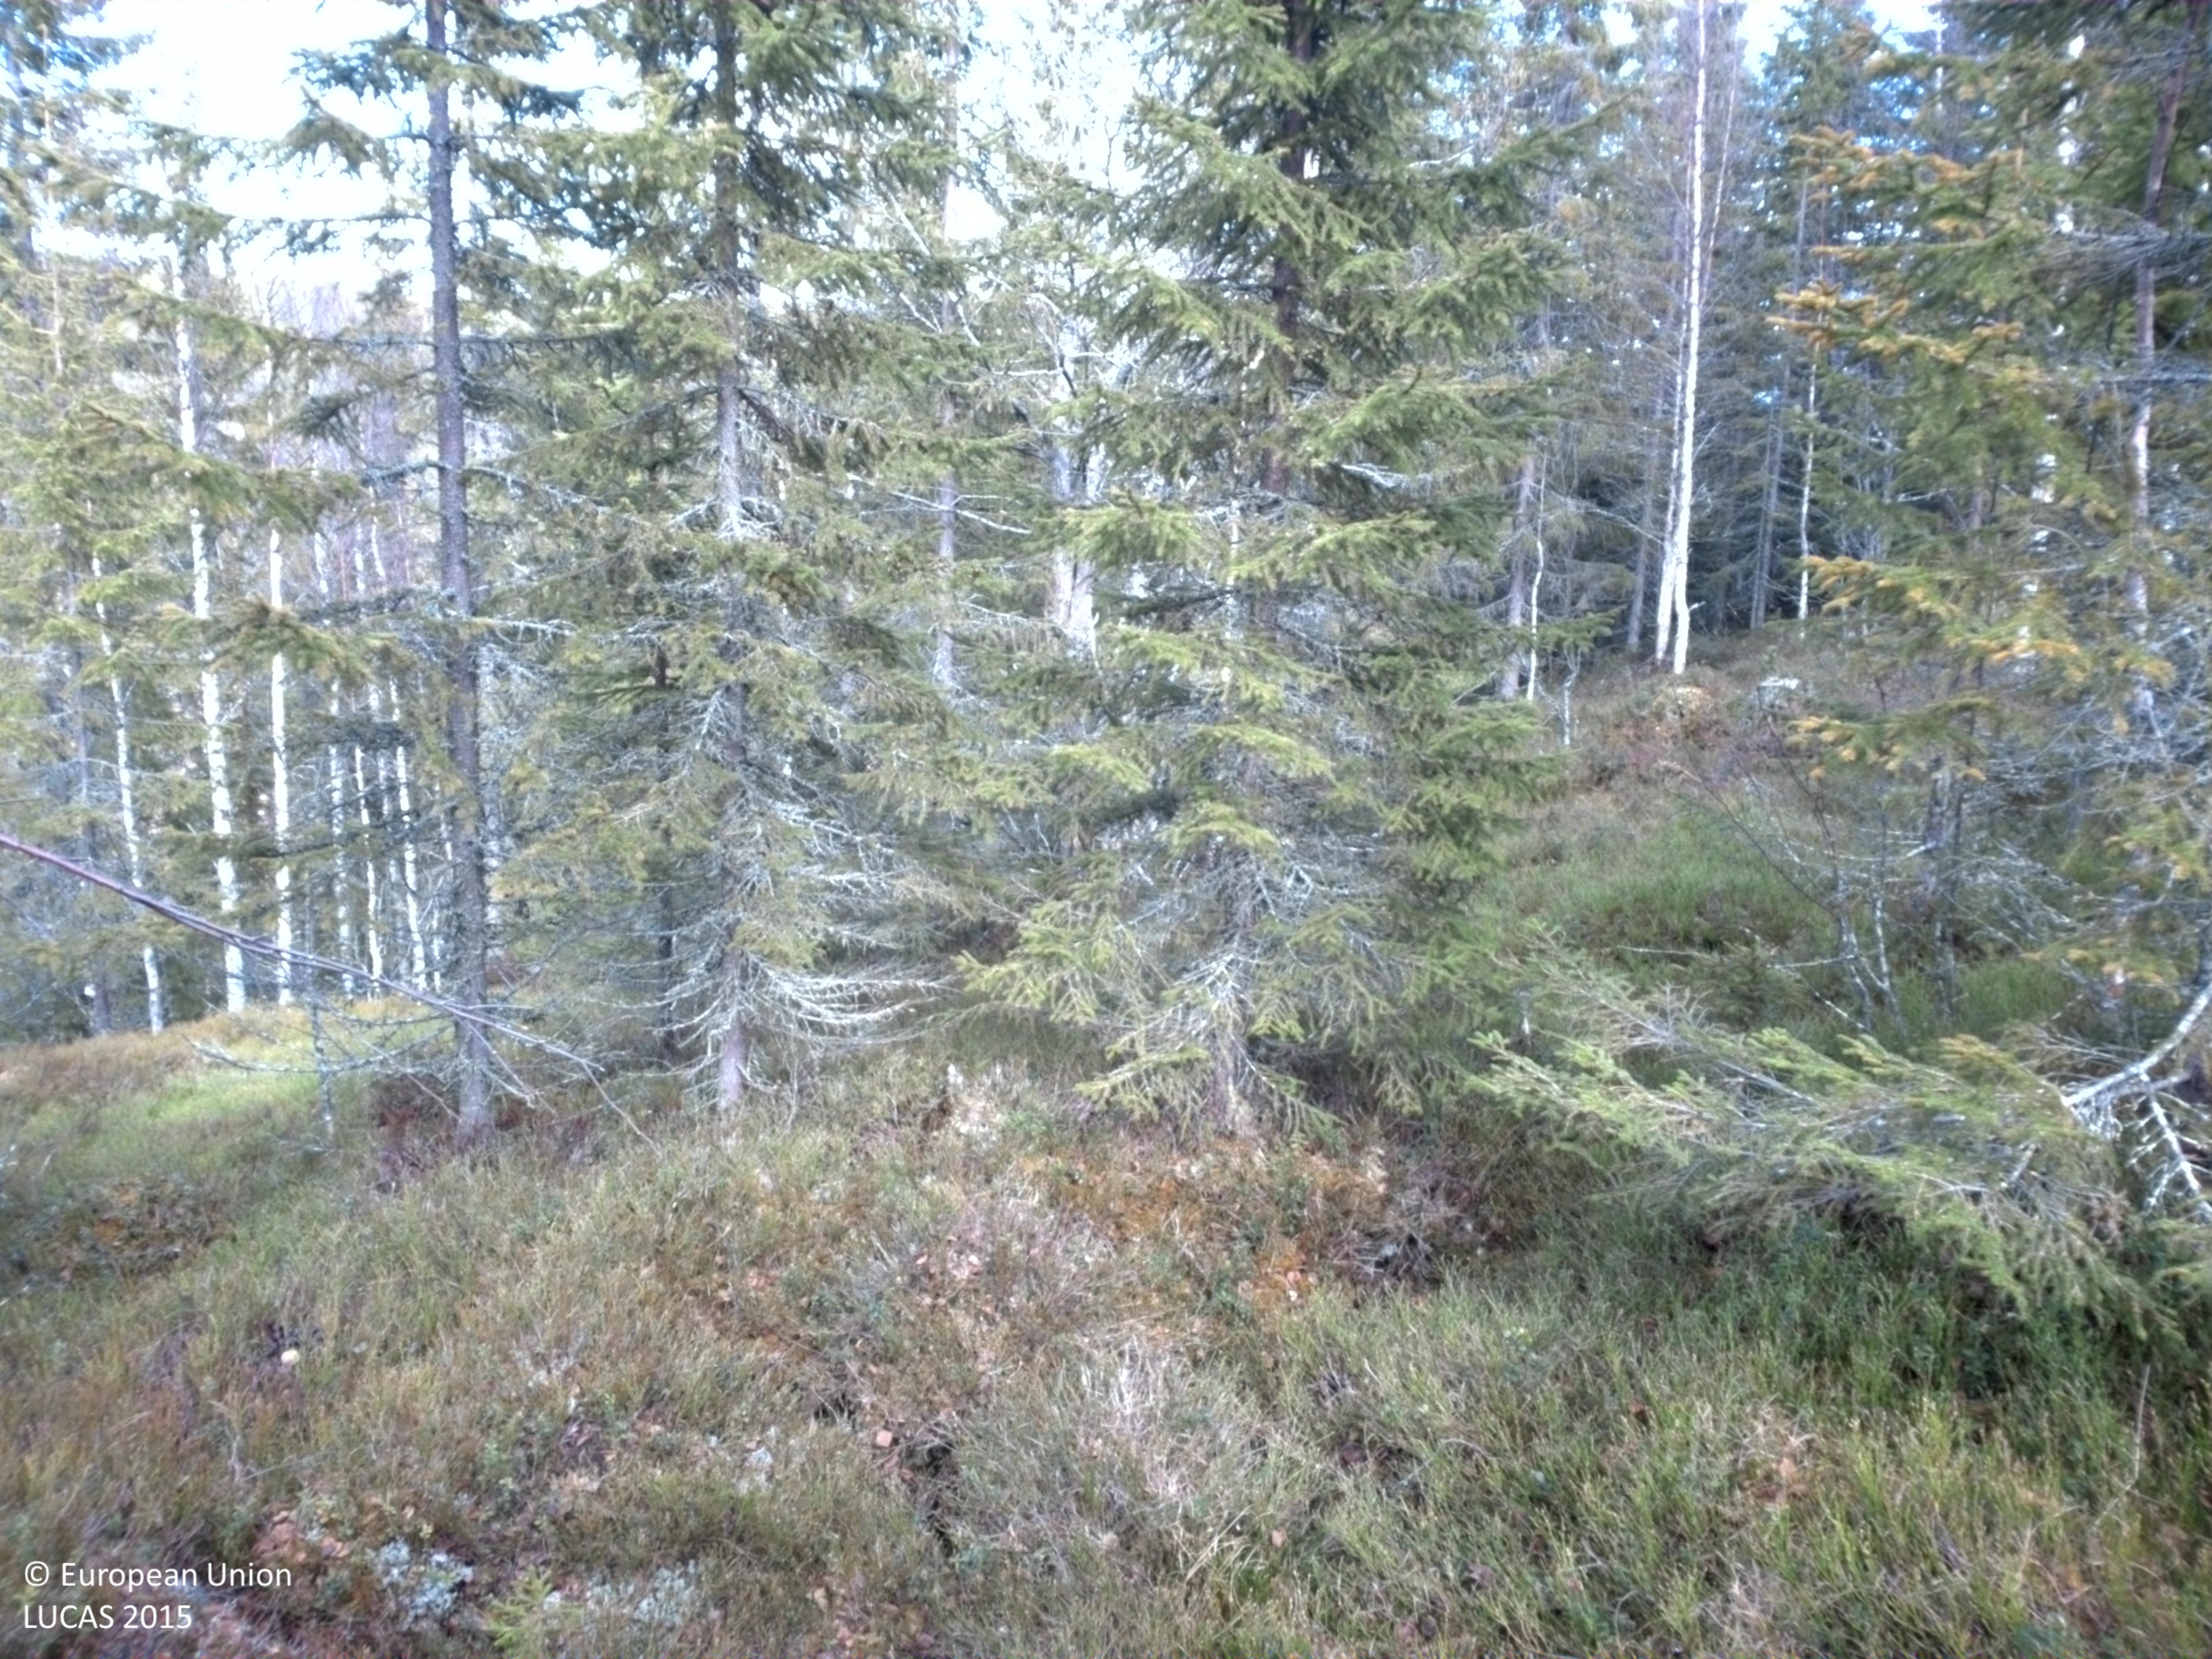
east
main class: Woodland
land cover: Spruce dominated coniferous woodland
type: boreal forest
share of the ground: 10 - 25 %
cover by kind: herbaceous plants 45 %, coniferous forest trees 25 %, shrubs 15 %, lichens and mosses 10 %, broadleaved forest trees 5 %
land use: Forestry
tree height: > 5 m
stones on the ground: 10 - 25 %
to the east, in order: Spruce dominated coniferous woodland; Peatbogs; Inland fresh running water; Peatbogs
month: May
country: SE
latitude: 64.1952
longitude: 18.0203
